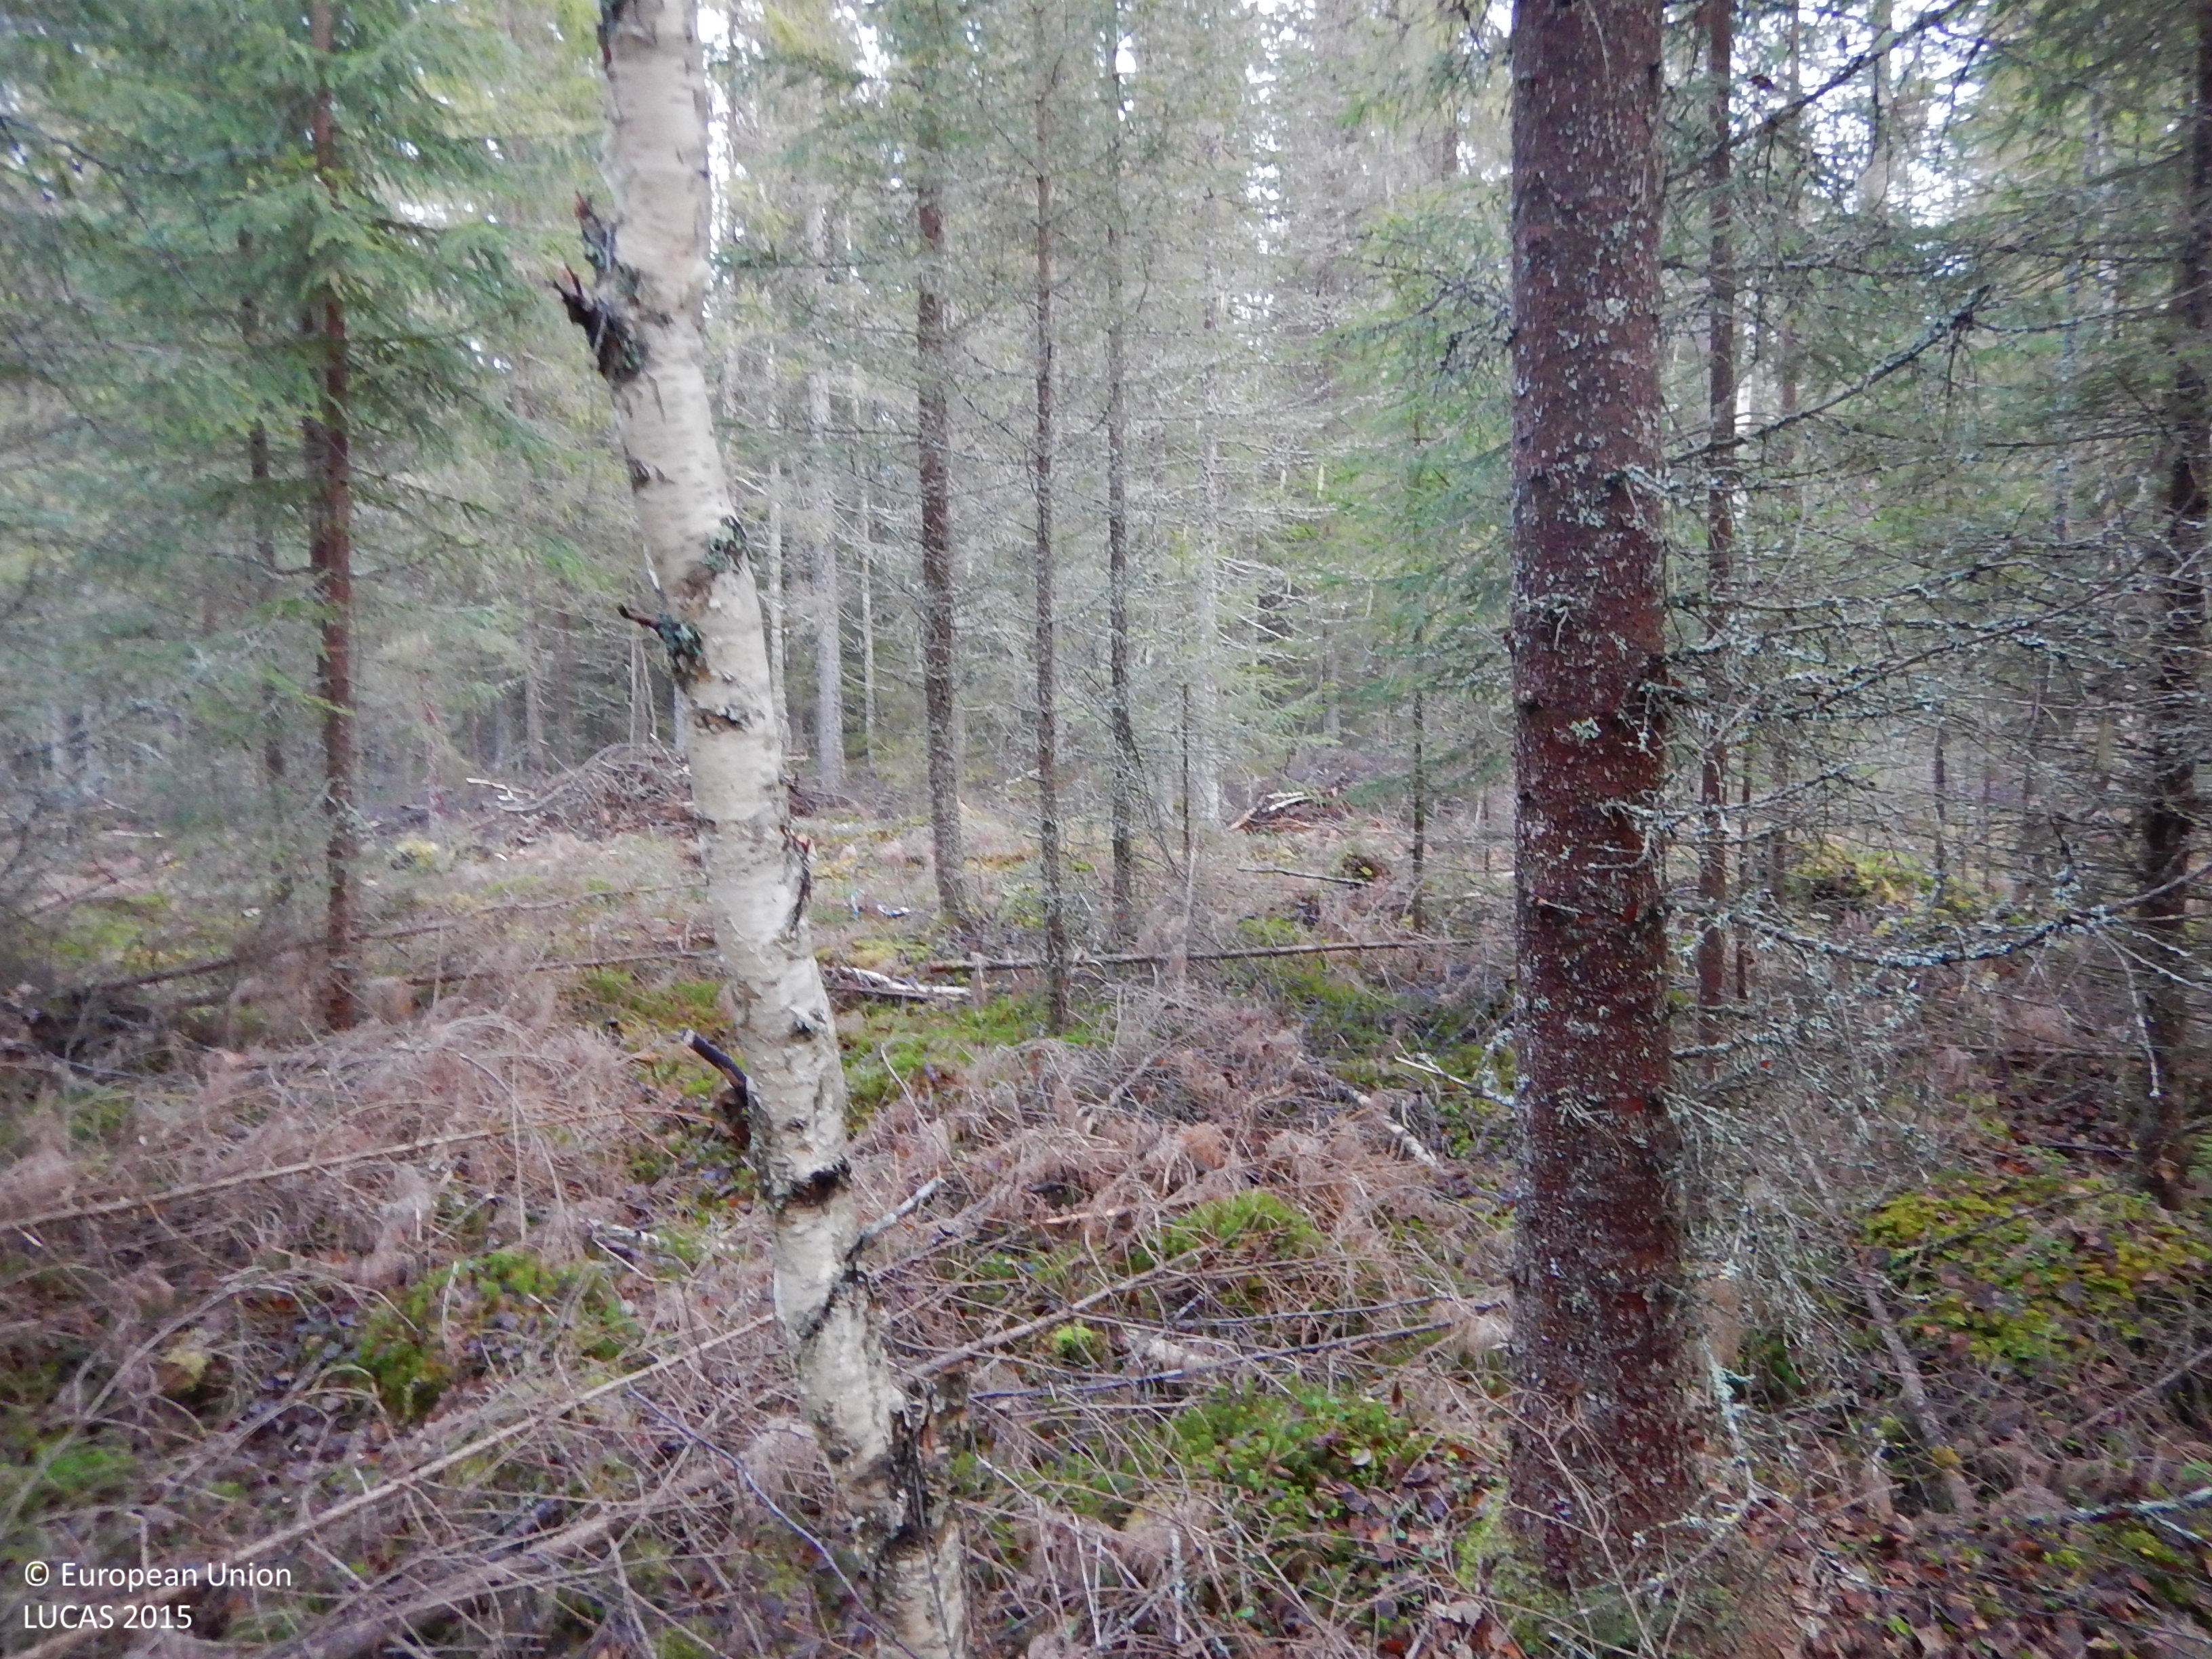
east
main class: Woodland
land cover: Spruce dominated mixed woodland
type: boreal forest
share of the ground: 50 - 75 %
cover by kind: coniferous forest trees 30 %, broadleaved forest trees 30 %, herbaceous plants 20 %, shrubs 10 %, lichens and mosses 10 %
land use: Forestry
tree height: > 5 m
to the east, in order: Spruce dominated mixed woodland; Ditches and canals; Grass margins; Paved roads, cycling and walking lanes; Grass margins; Ditches and canals; Spruce dominated coniferous woodland
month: October
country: SE
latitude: 65.4063
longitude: 21.2355
